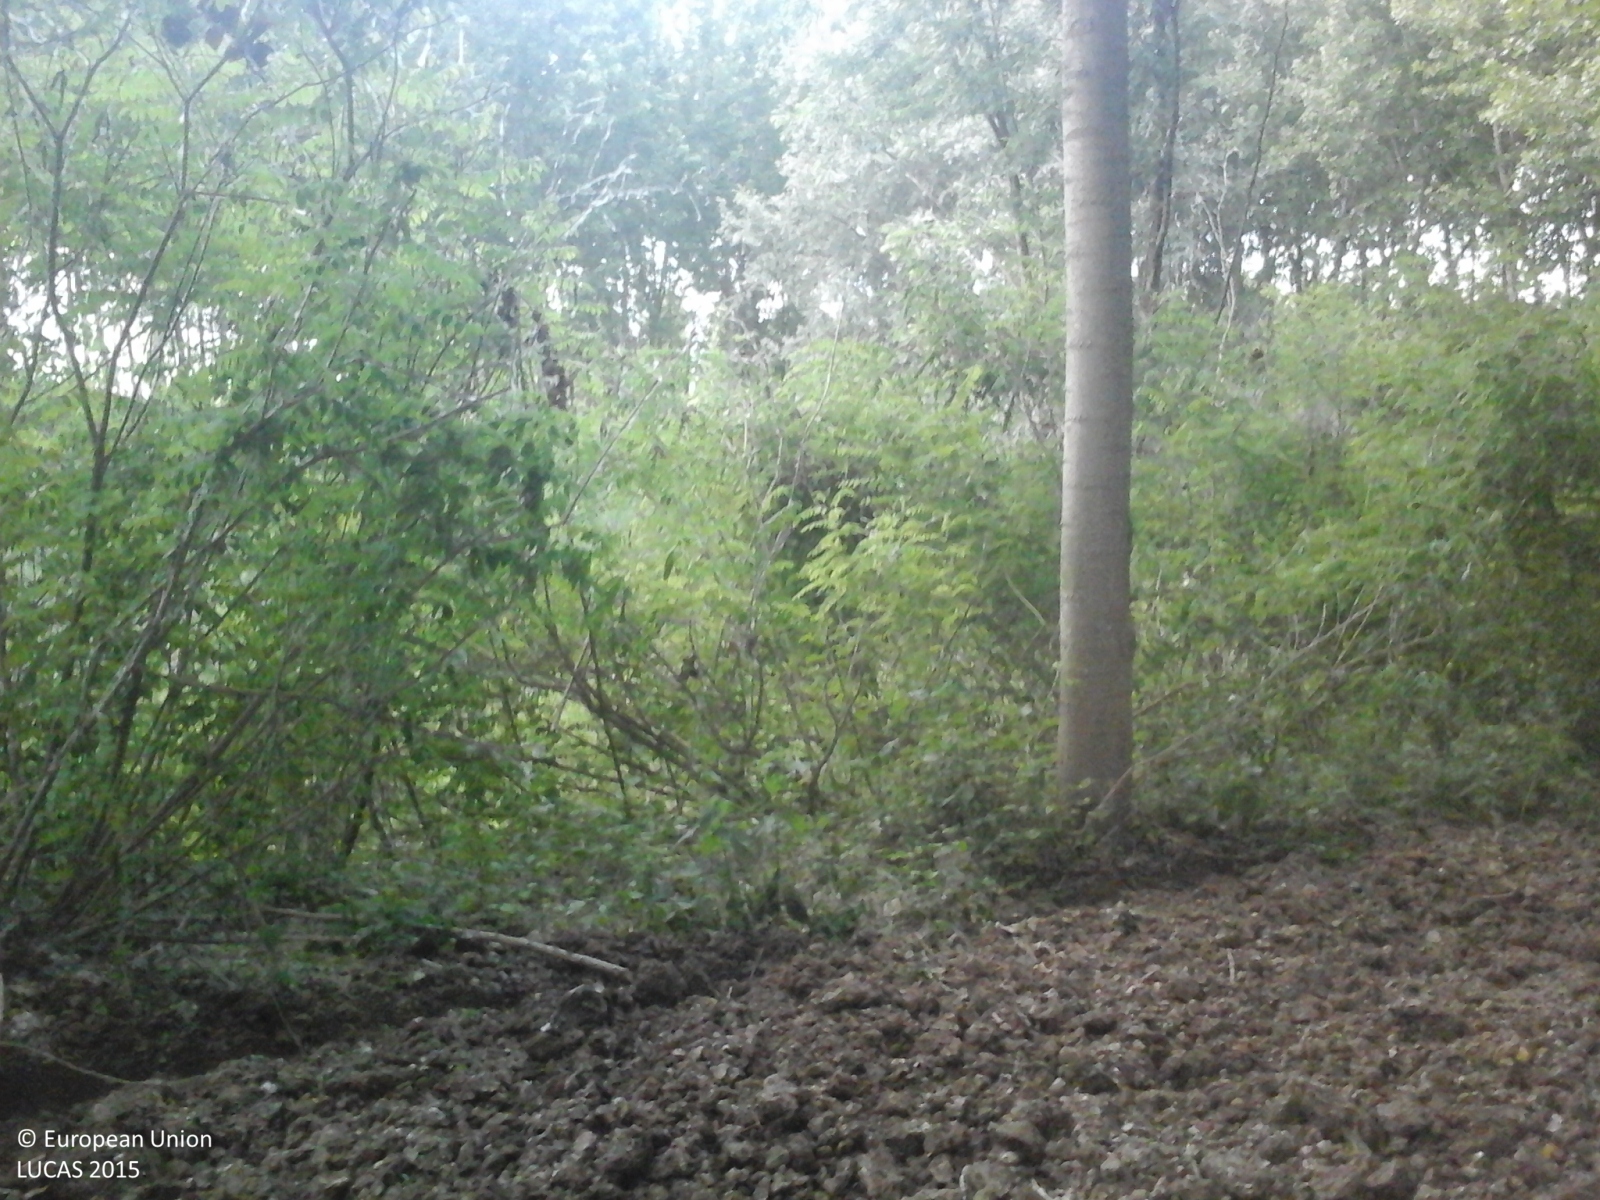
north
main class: Woodland
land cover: Broadleaved woodland
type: non-riverine alder, birch or aspen forest
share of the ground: > 75 %
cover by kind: broadleaved forest trees 100 %
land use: Forestry
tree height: > 5 m
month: May
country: IT
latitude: 45.0680
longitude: 10.9000
